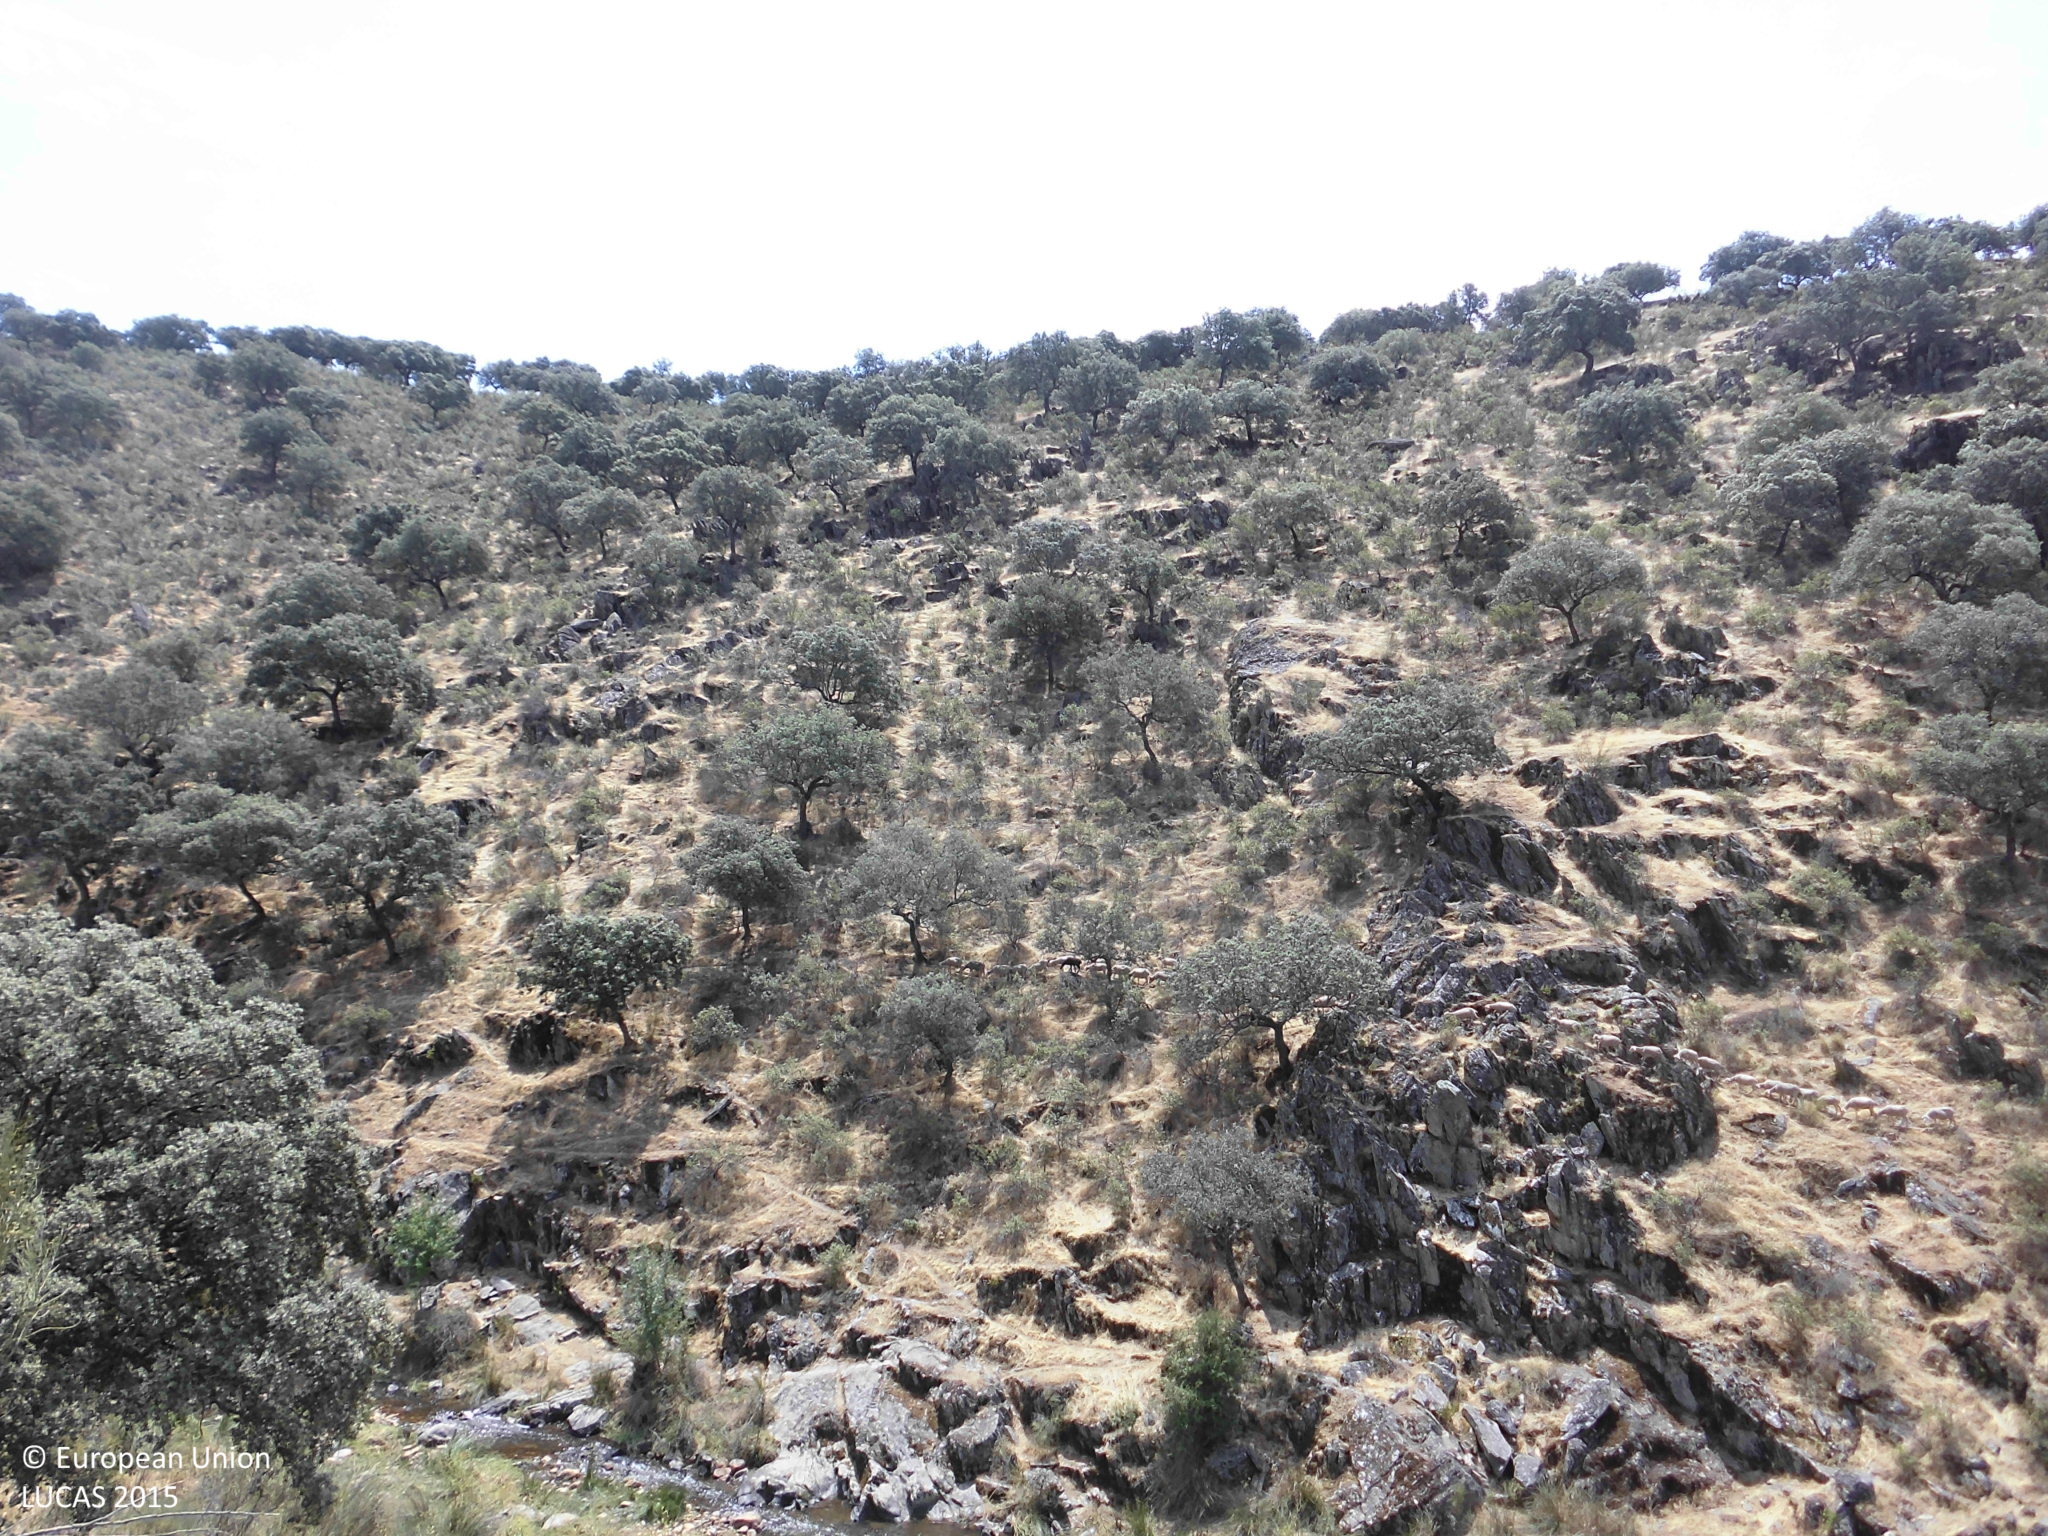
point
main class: Shrubland
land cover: Shrubland with sparse tree cover
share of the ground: 50 - 75 %
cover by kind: shrubs 50 %, herbaceous plants 45 %, broadleaved forest trees 5 %
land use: Agriculture (excluding fallow land and kitchen gardens)
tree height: > 5 m
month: June
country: ES
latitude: 39.5533
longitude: -5.5435
